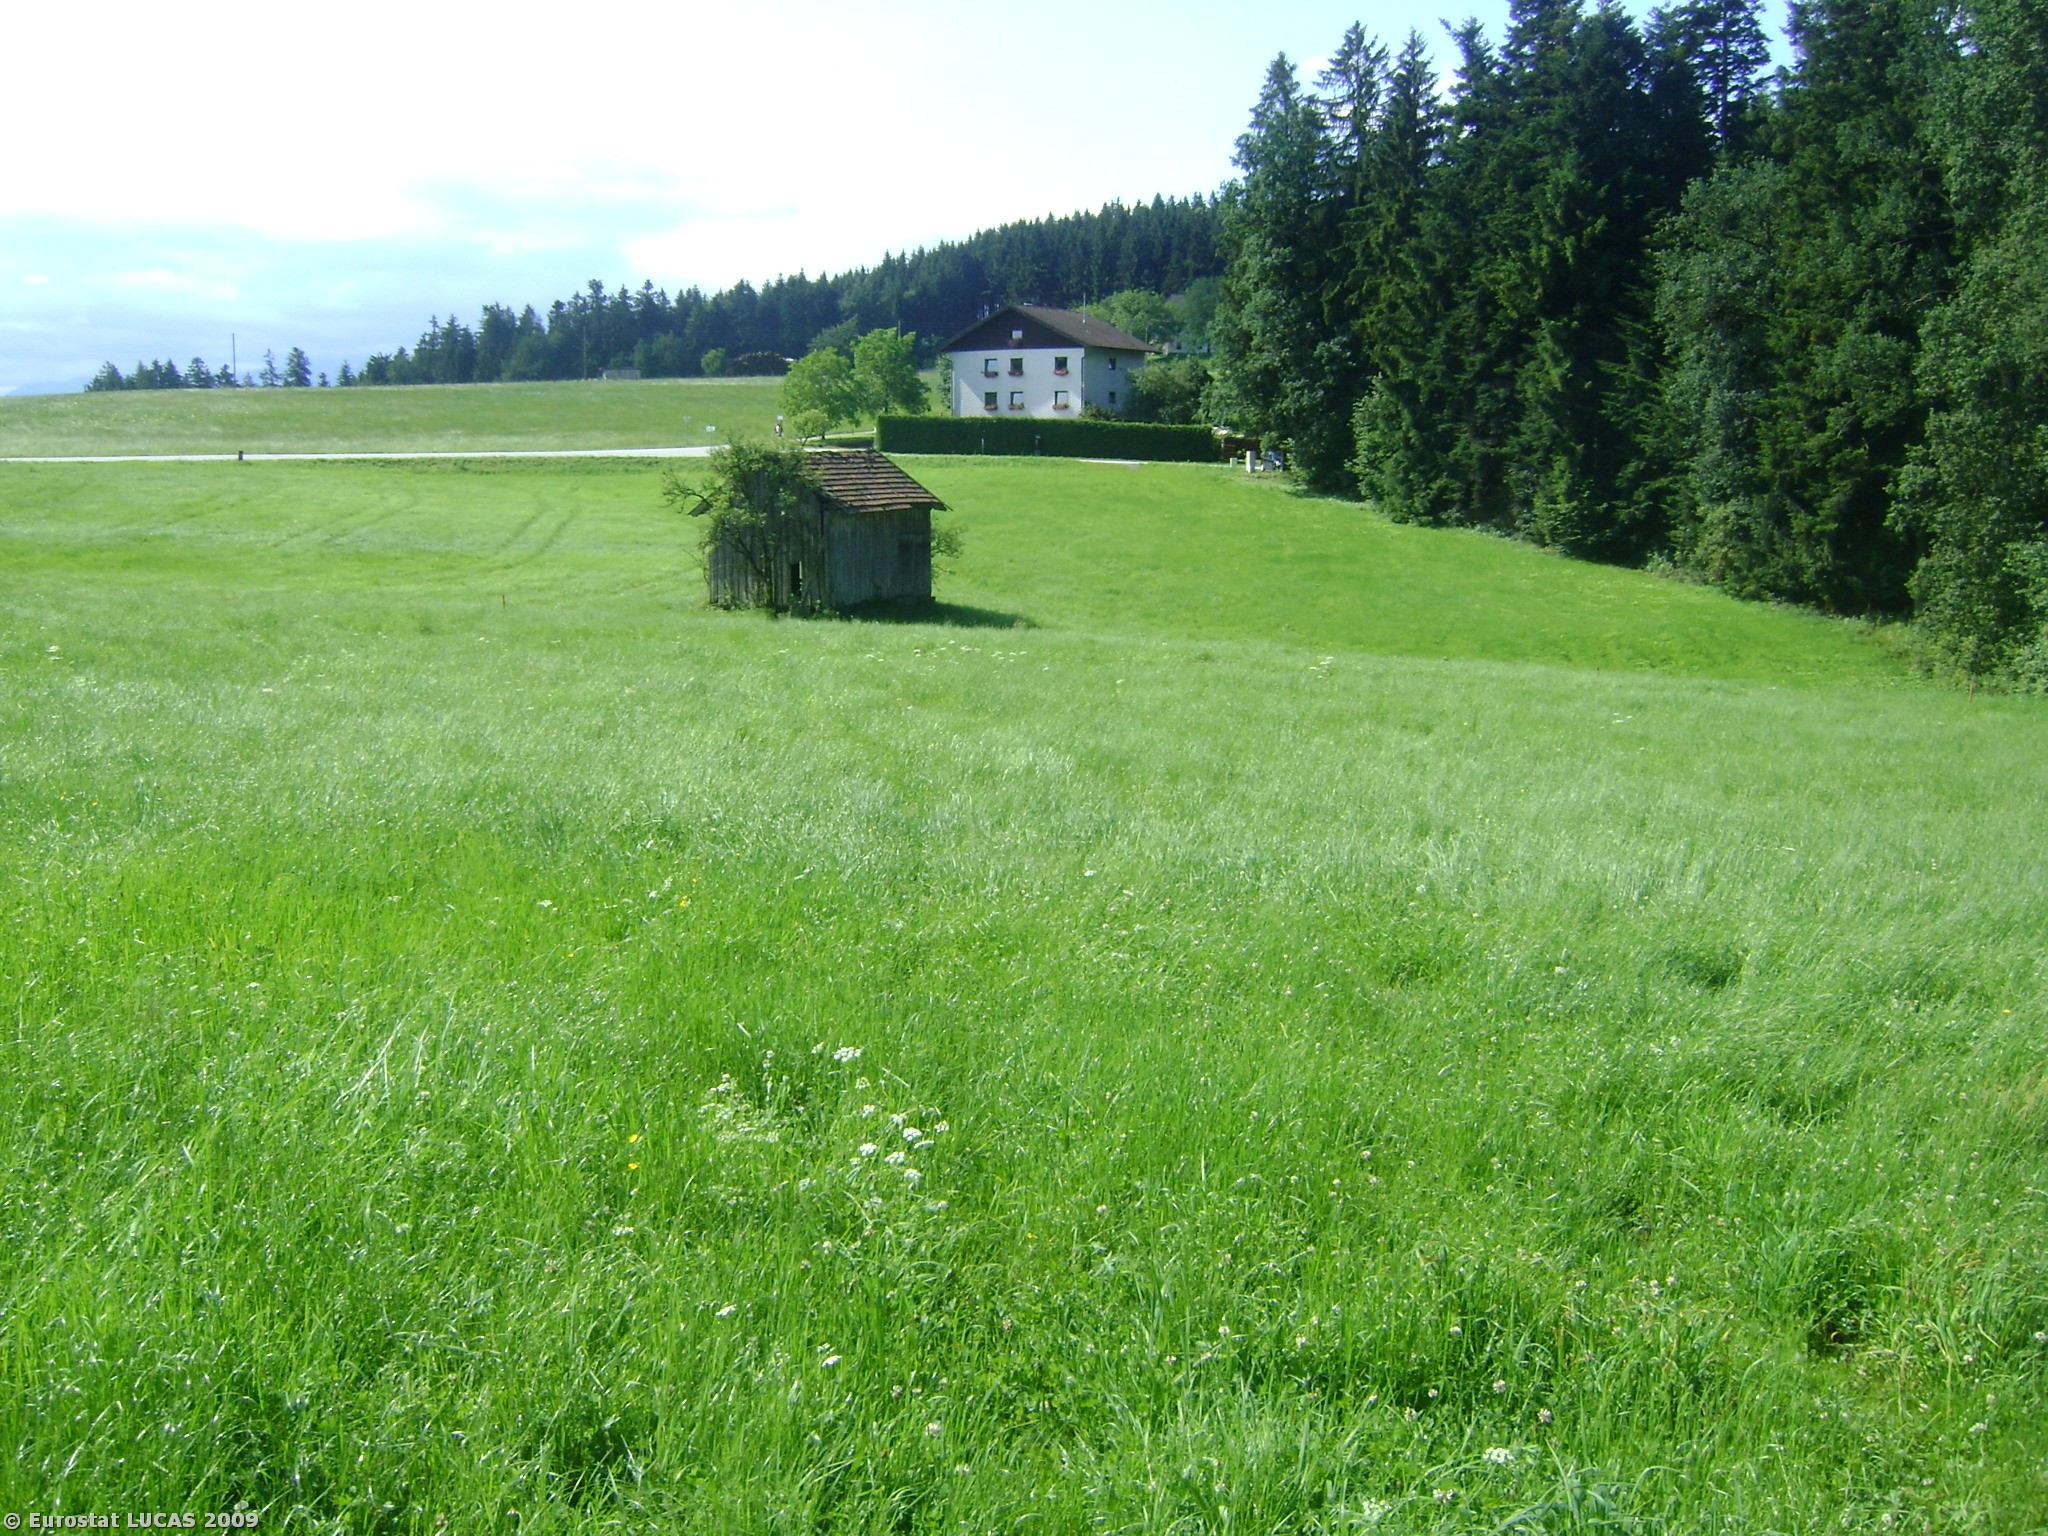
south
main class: Grassland
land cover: Grassland without tree/shrub cover
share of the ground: > 75 %
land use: Agriculture (excluding fallow land and kitchen gardens)
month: July
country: AT
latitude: 48.0411
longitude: 13.5268
